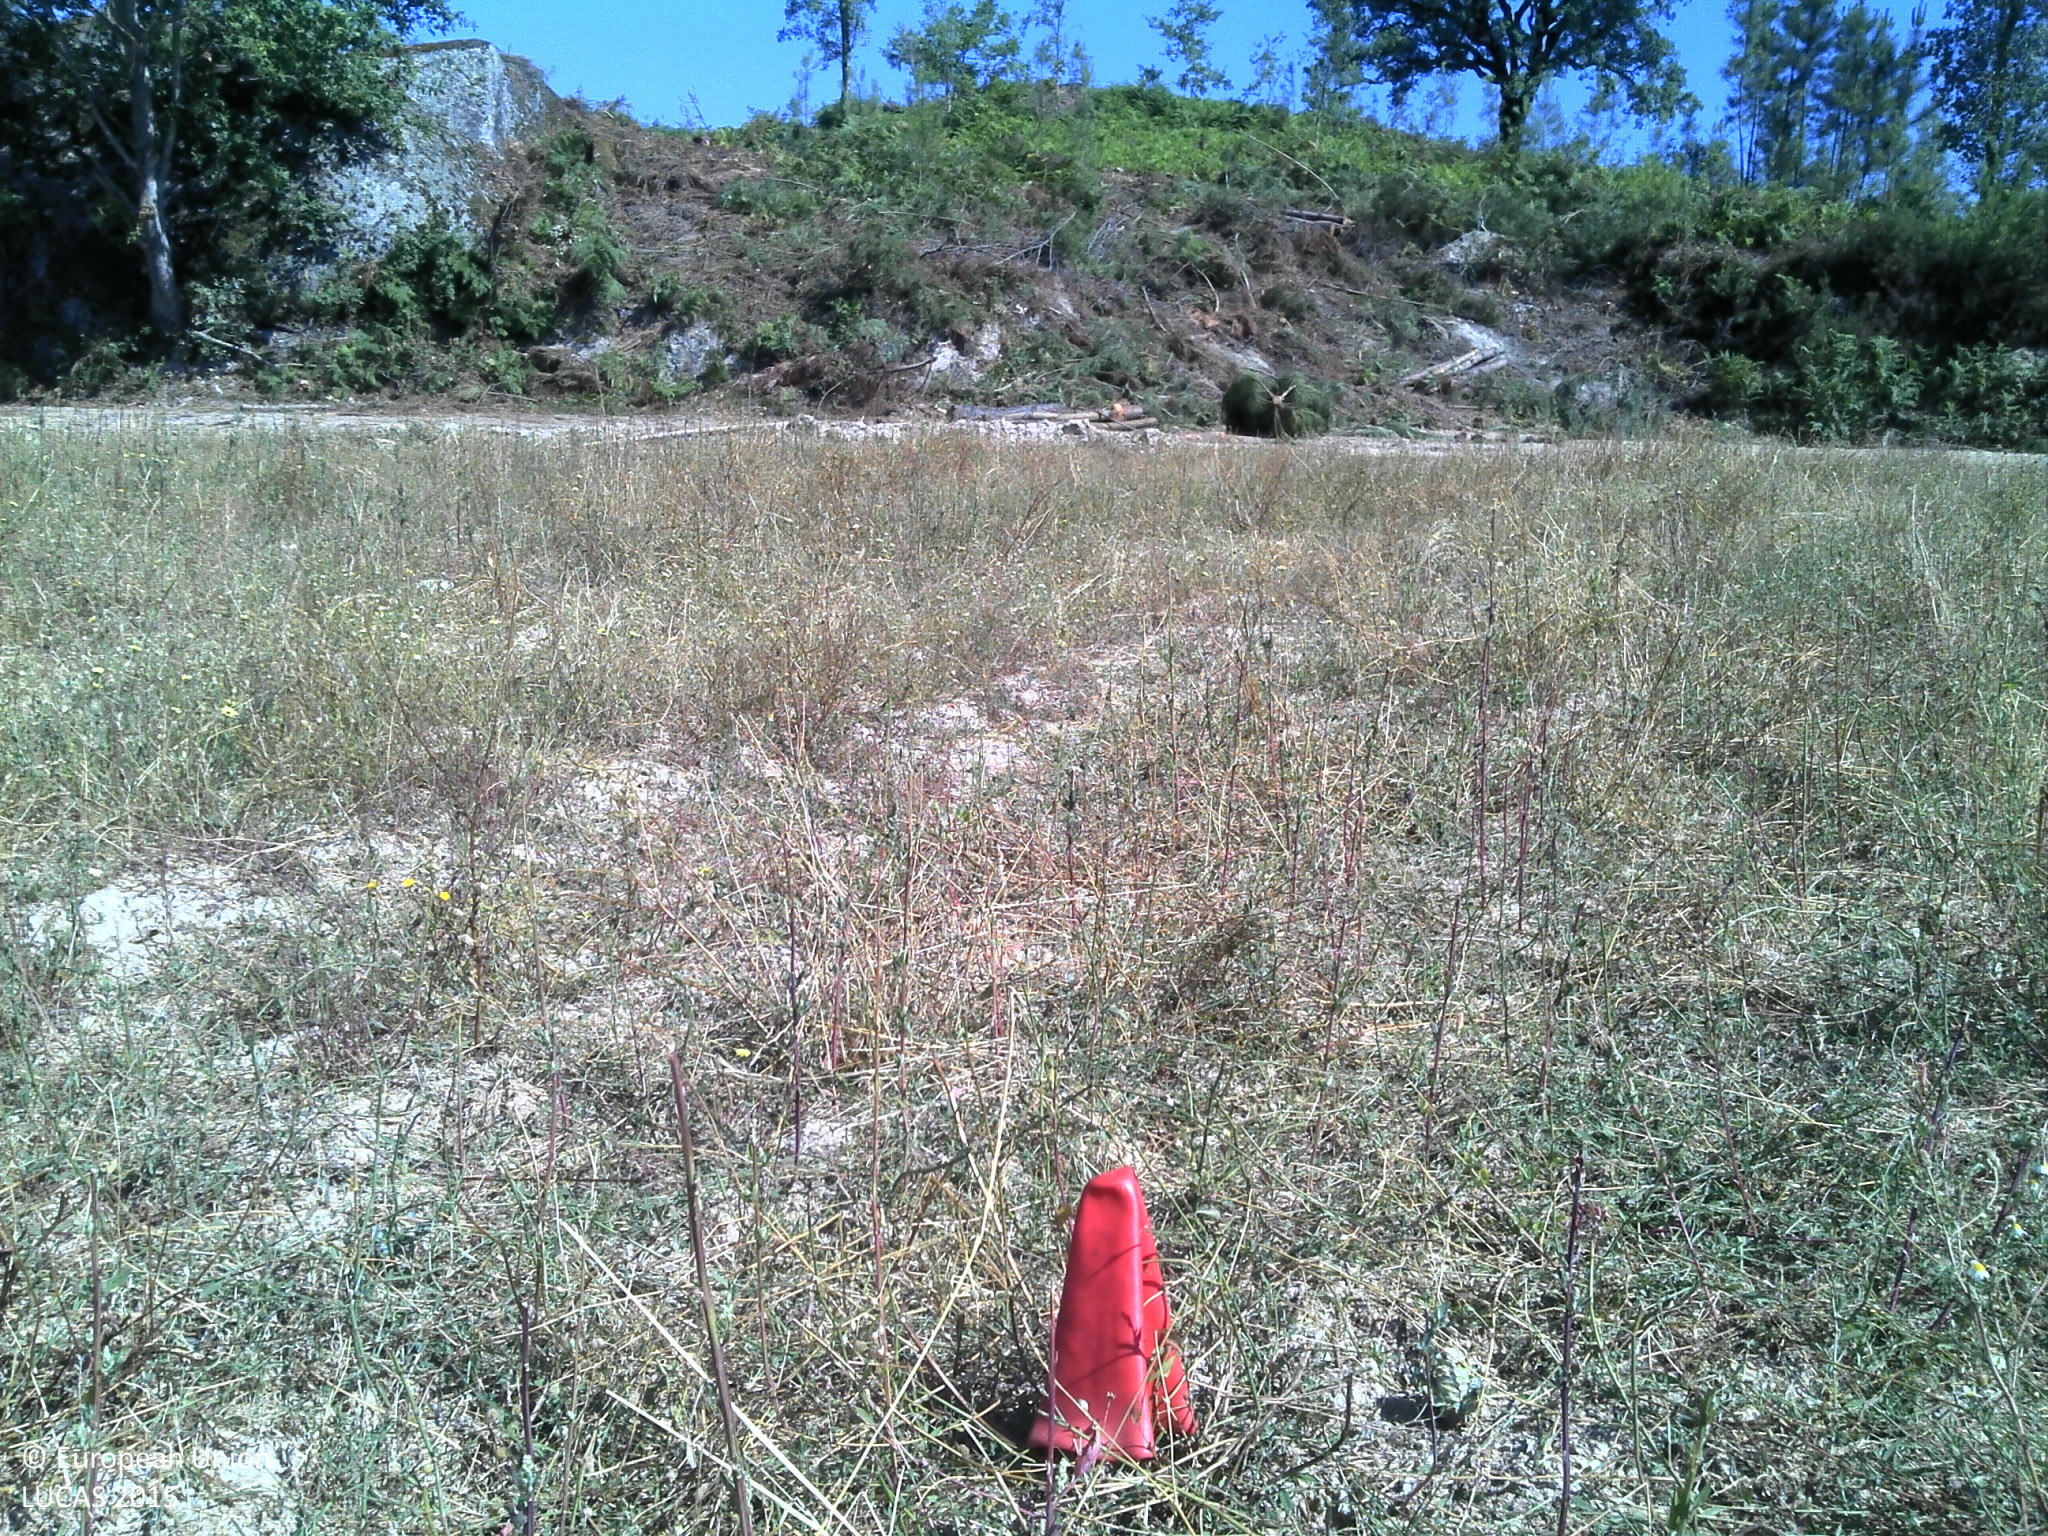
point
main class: Grassland
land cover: Spontaneously vegetated surfaces
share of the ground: > 75 %
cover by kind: herbaceous plants 75 %, unconsolidated bare surface 25 %
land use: Agriculture (excluding fallow land and kitchen gardens)
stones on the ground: < 10 %
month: June
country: PT
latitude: 40.5956
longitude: -8.0285
